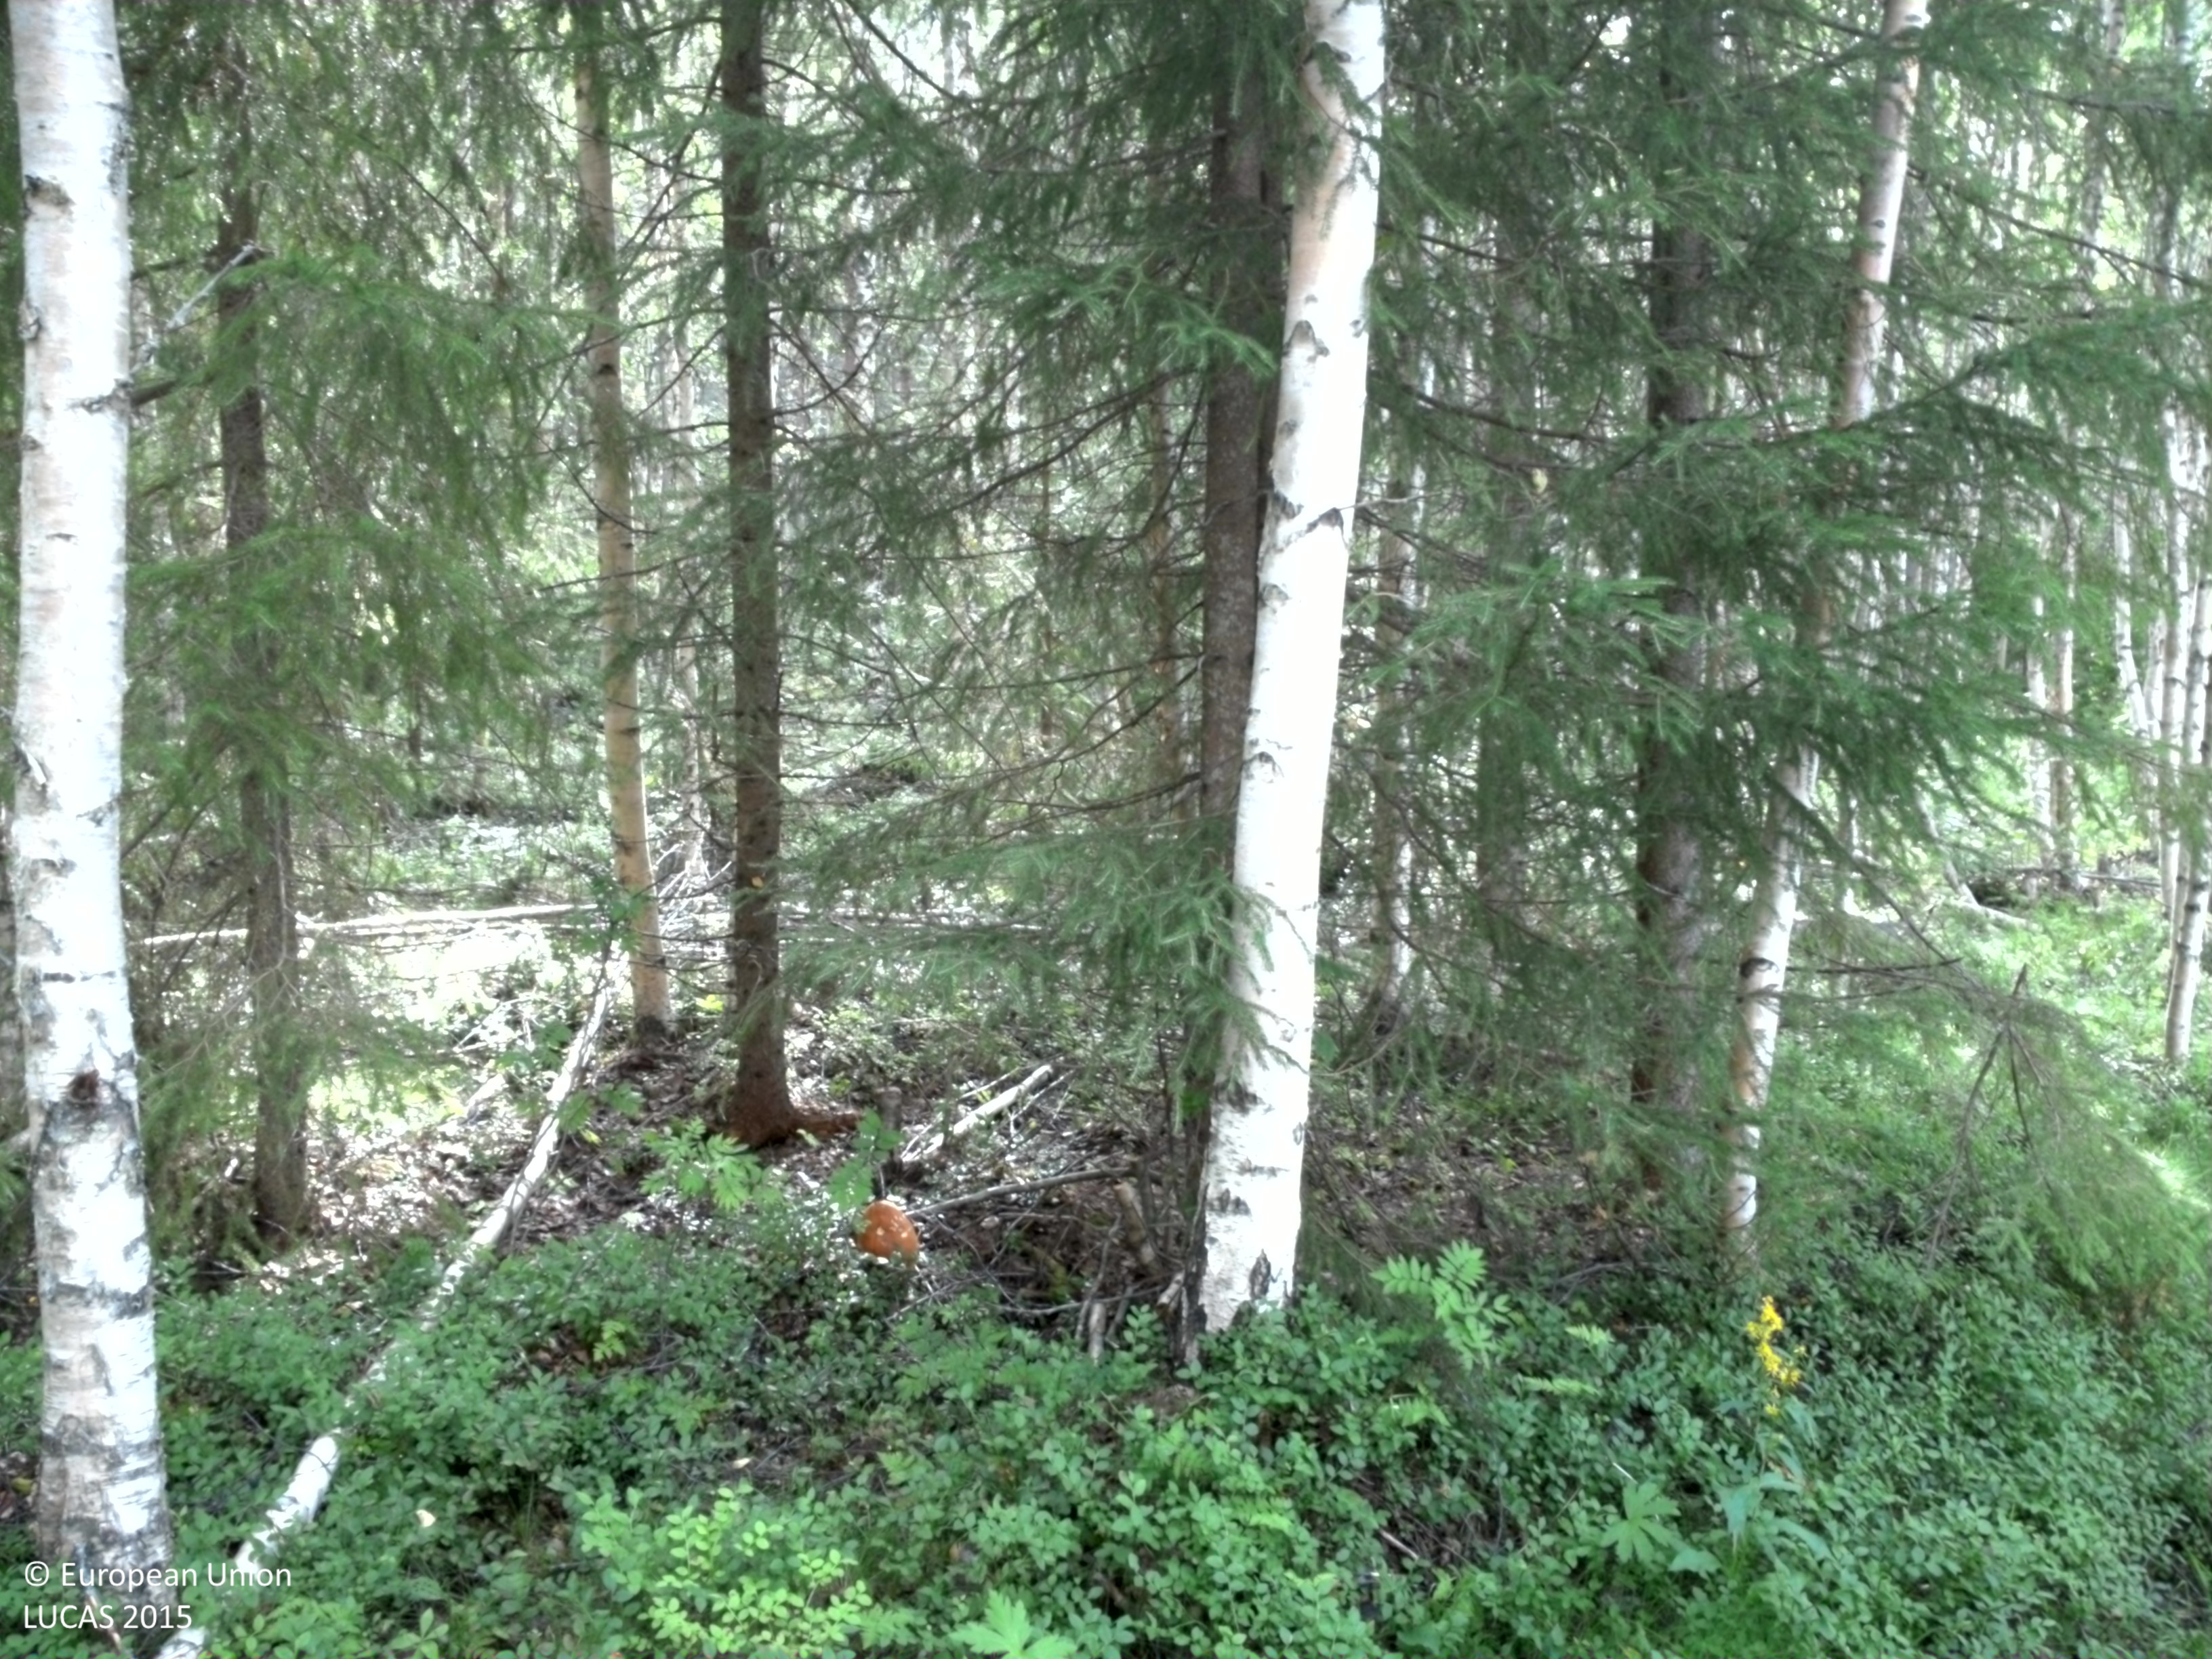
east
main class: Woodland
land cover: Other mixed woodland
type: boreal forest
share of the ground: > 75 %
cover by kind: broadleaved forest trees 45 %, coniferous forest trees 35 %, shrubs 10 %, herbaceous plants 10 %
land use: Forestry
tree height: > 5 m
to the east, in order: Tracks; Other mixed woodland; Pine dominated mixed woodland; Pine dominated coniferous woodland
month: August
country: SE
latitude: 64.6853
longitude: 20.8141
